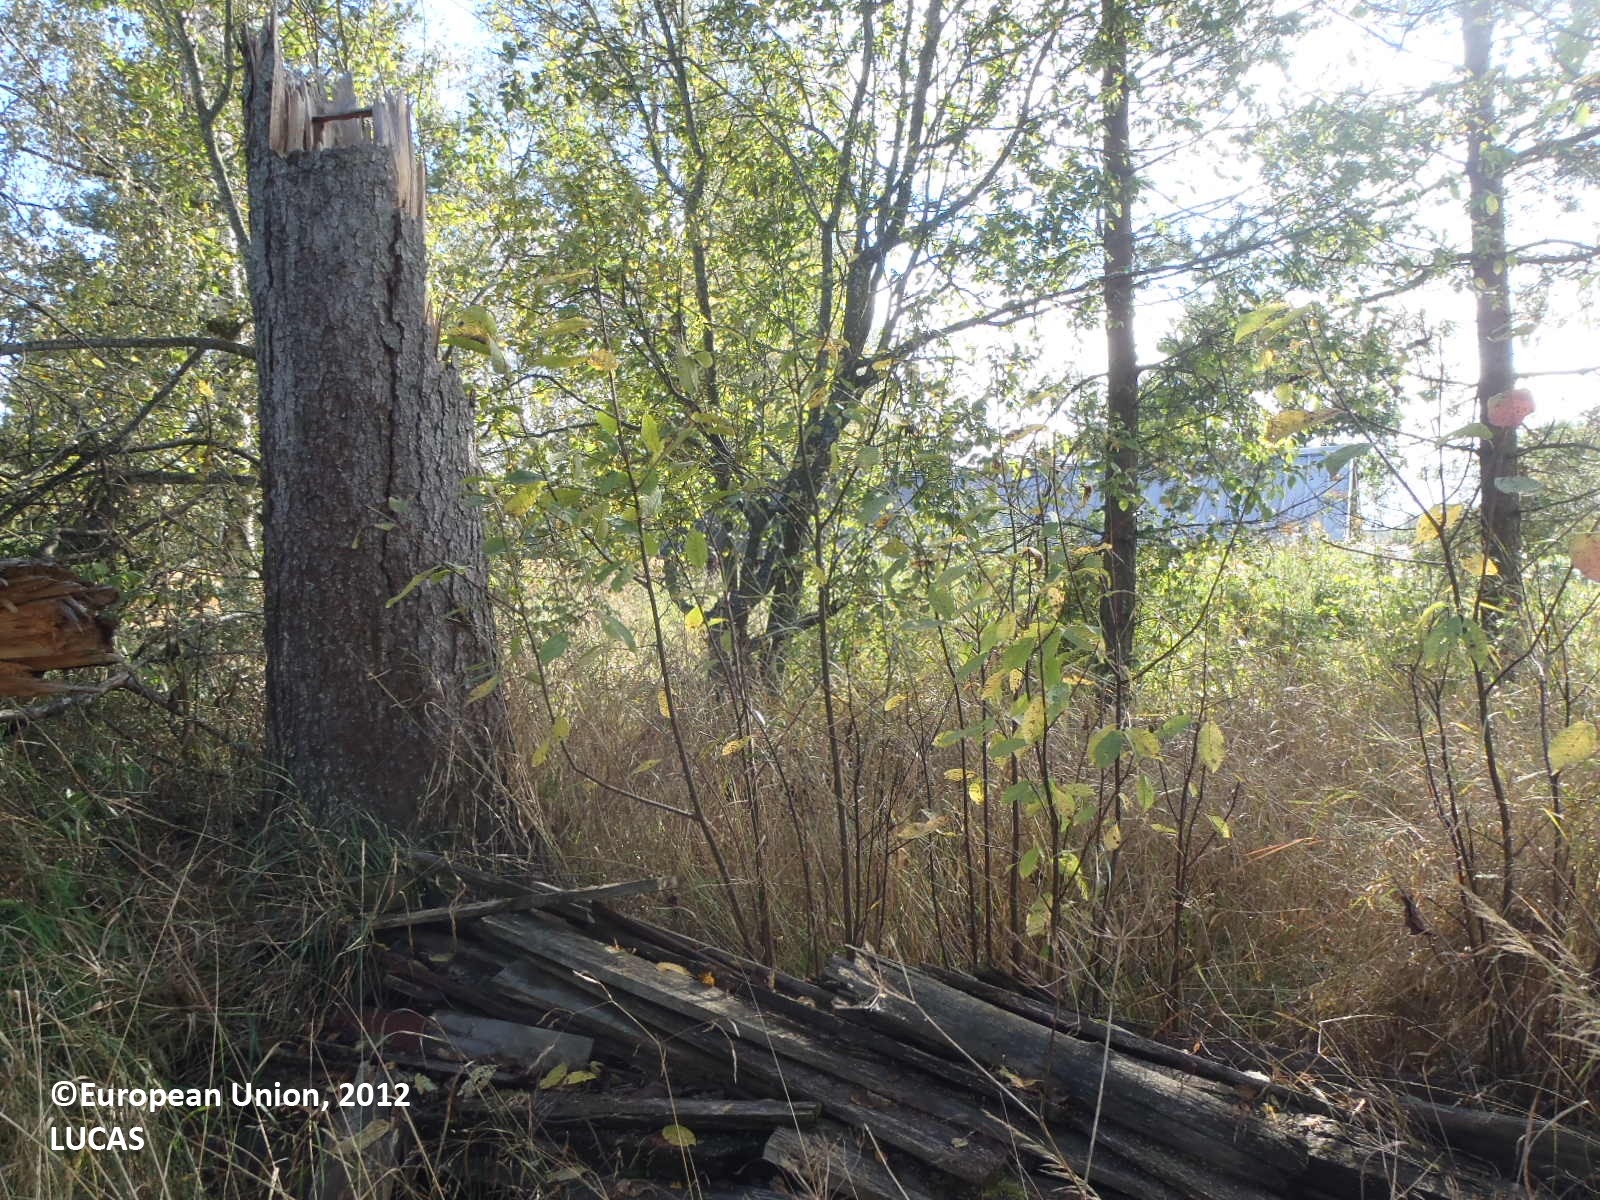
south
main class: Woodland
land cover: Spruce dominated mixed woodland
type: boreal forest
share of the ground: > 75 %
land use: Forestry
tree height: > 5 m
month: September
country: FI
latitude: 60.8917
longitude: 22.8062
